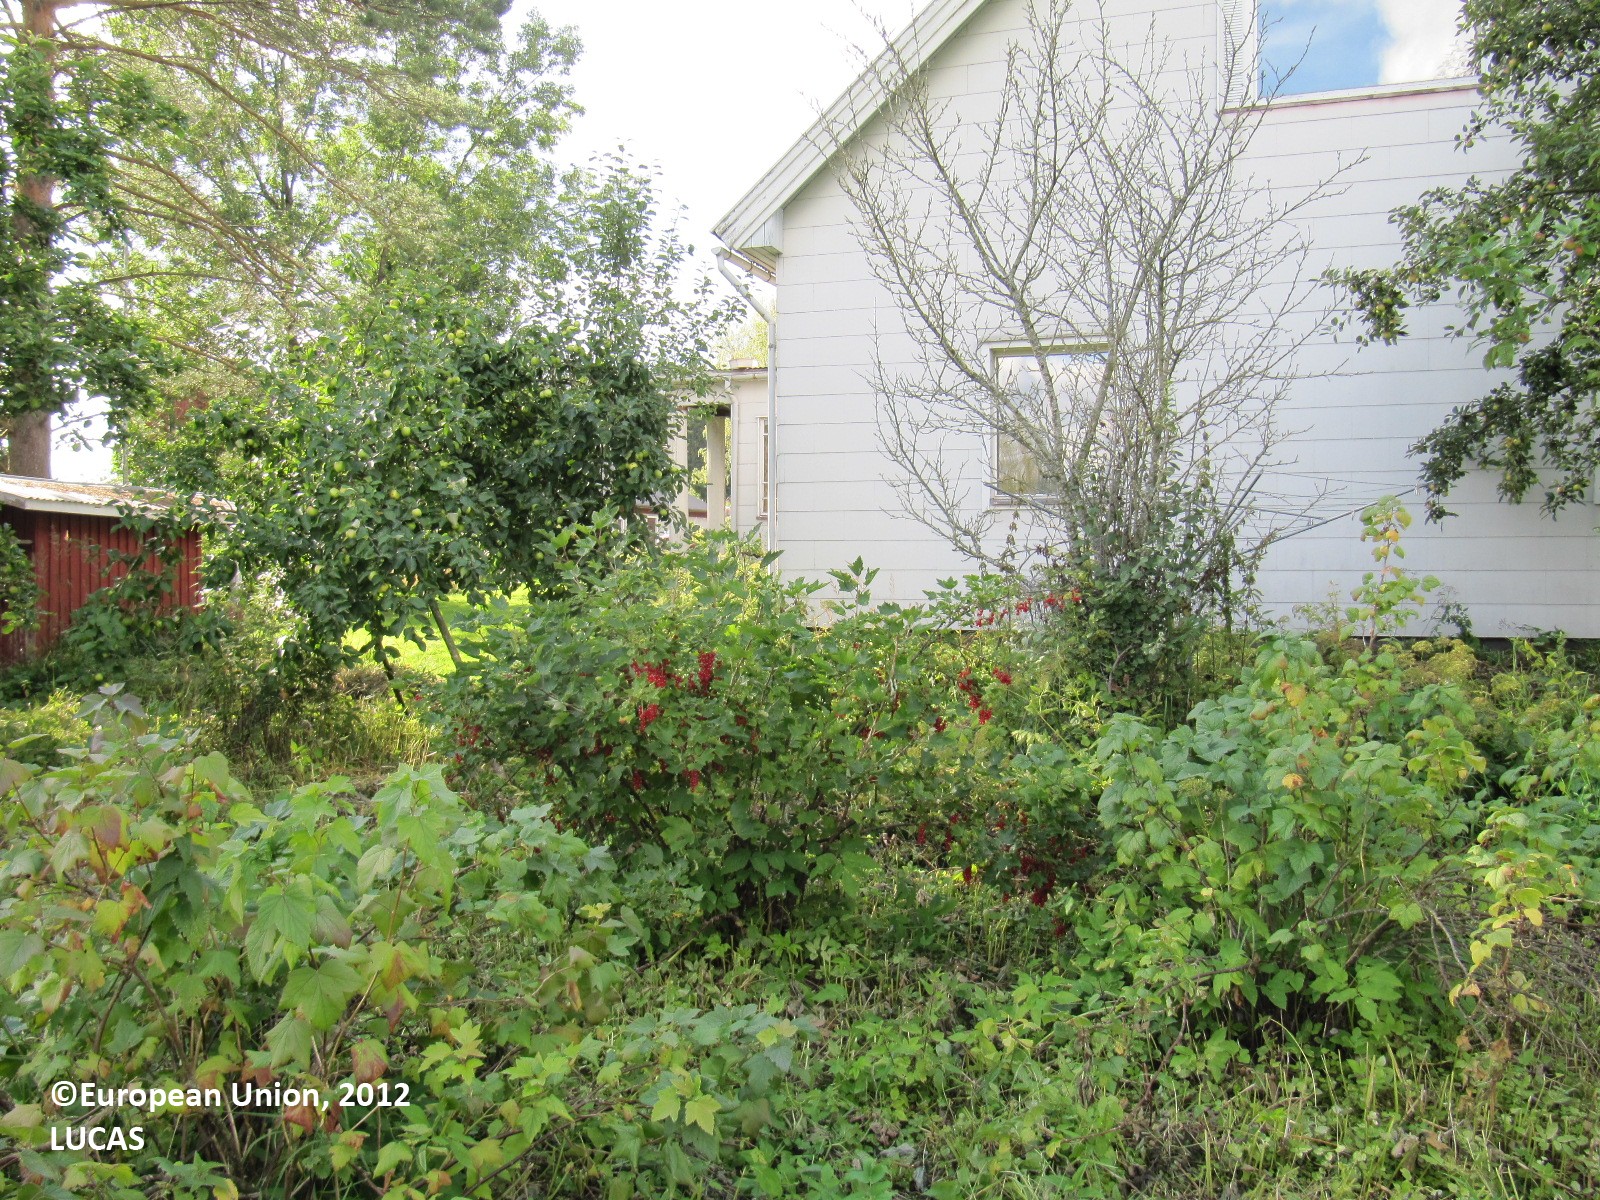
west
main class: Cropland
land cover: Other fruit trees and berries
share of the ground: 50 - 75 %
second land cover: Apple fruit
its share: 25 - 50 %
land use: Kitchen garden
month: August
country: FI
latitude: 60.5887
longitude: 24.4348
